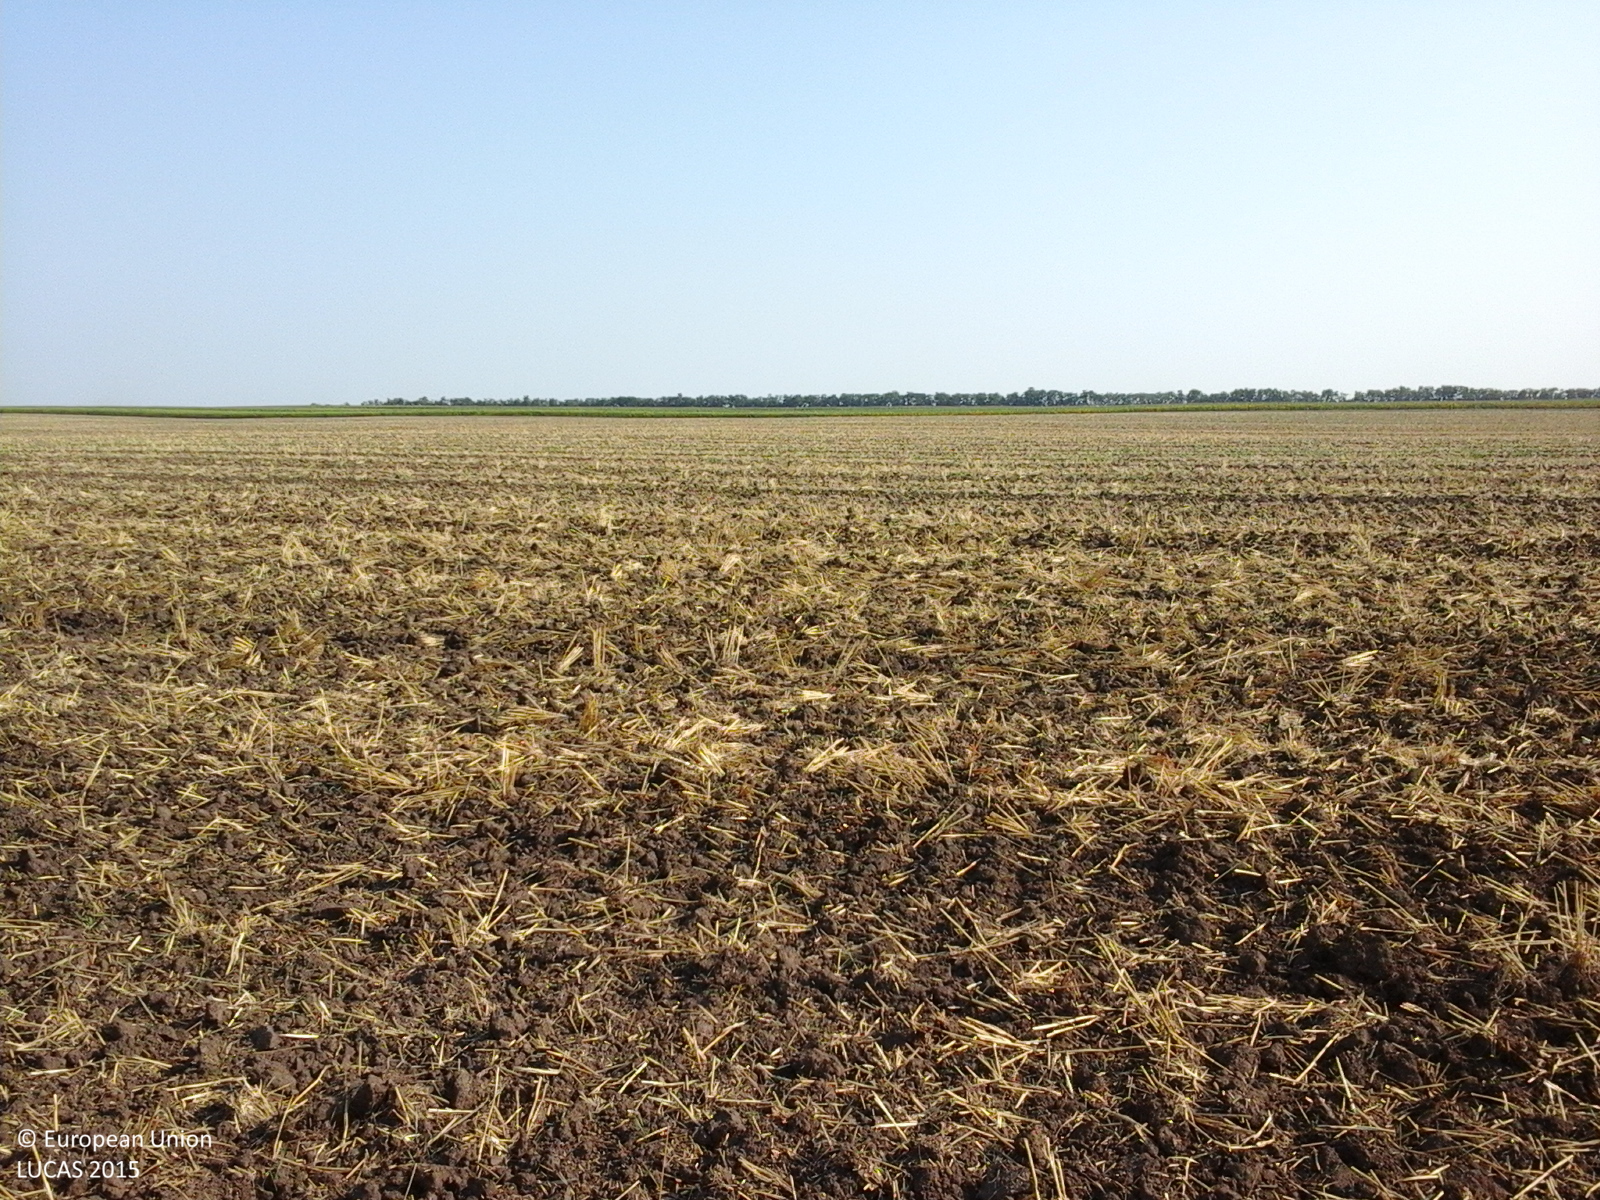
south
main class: Cropland
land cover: Common wheat
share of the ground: < 10 %
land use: Agriculture (excluding fallow land and kitchen gardens)
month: July
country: RO
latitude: 44.8593
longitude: 27.1580
